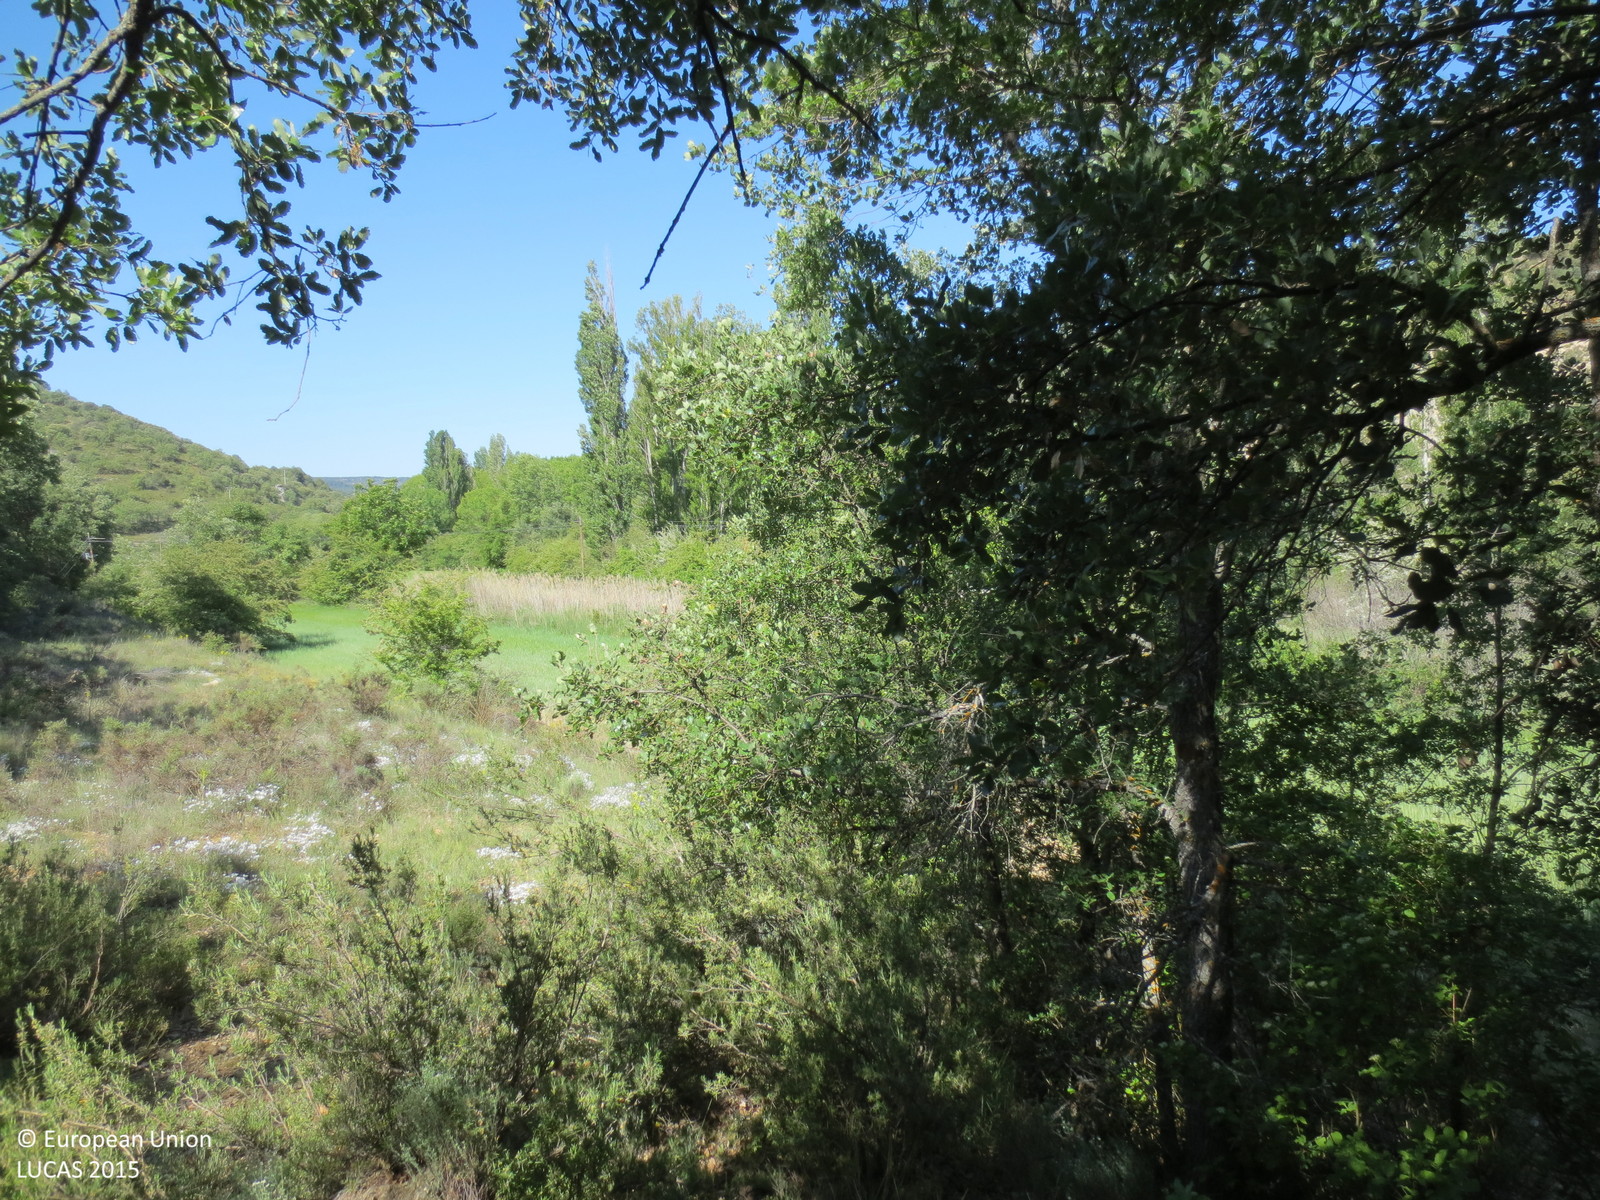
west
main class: Woodland
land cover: Broadleaved woodland
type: thermophilous deciduous forest
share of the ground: 25 - 50 %
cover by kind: broadleaved forest trees 45 %, shrubs 20 %, herbaceous plants 20 %, consolidated bare surface 10 %, coniferous forest trees 5 %
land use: Semi-natural and natural areas not in use
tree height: < 5 m
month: May
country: ES
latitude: 40.6434
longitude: -2.5731
